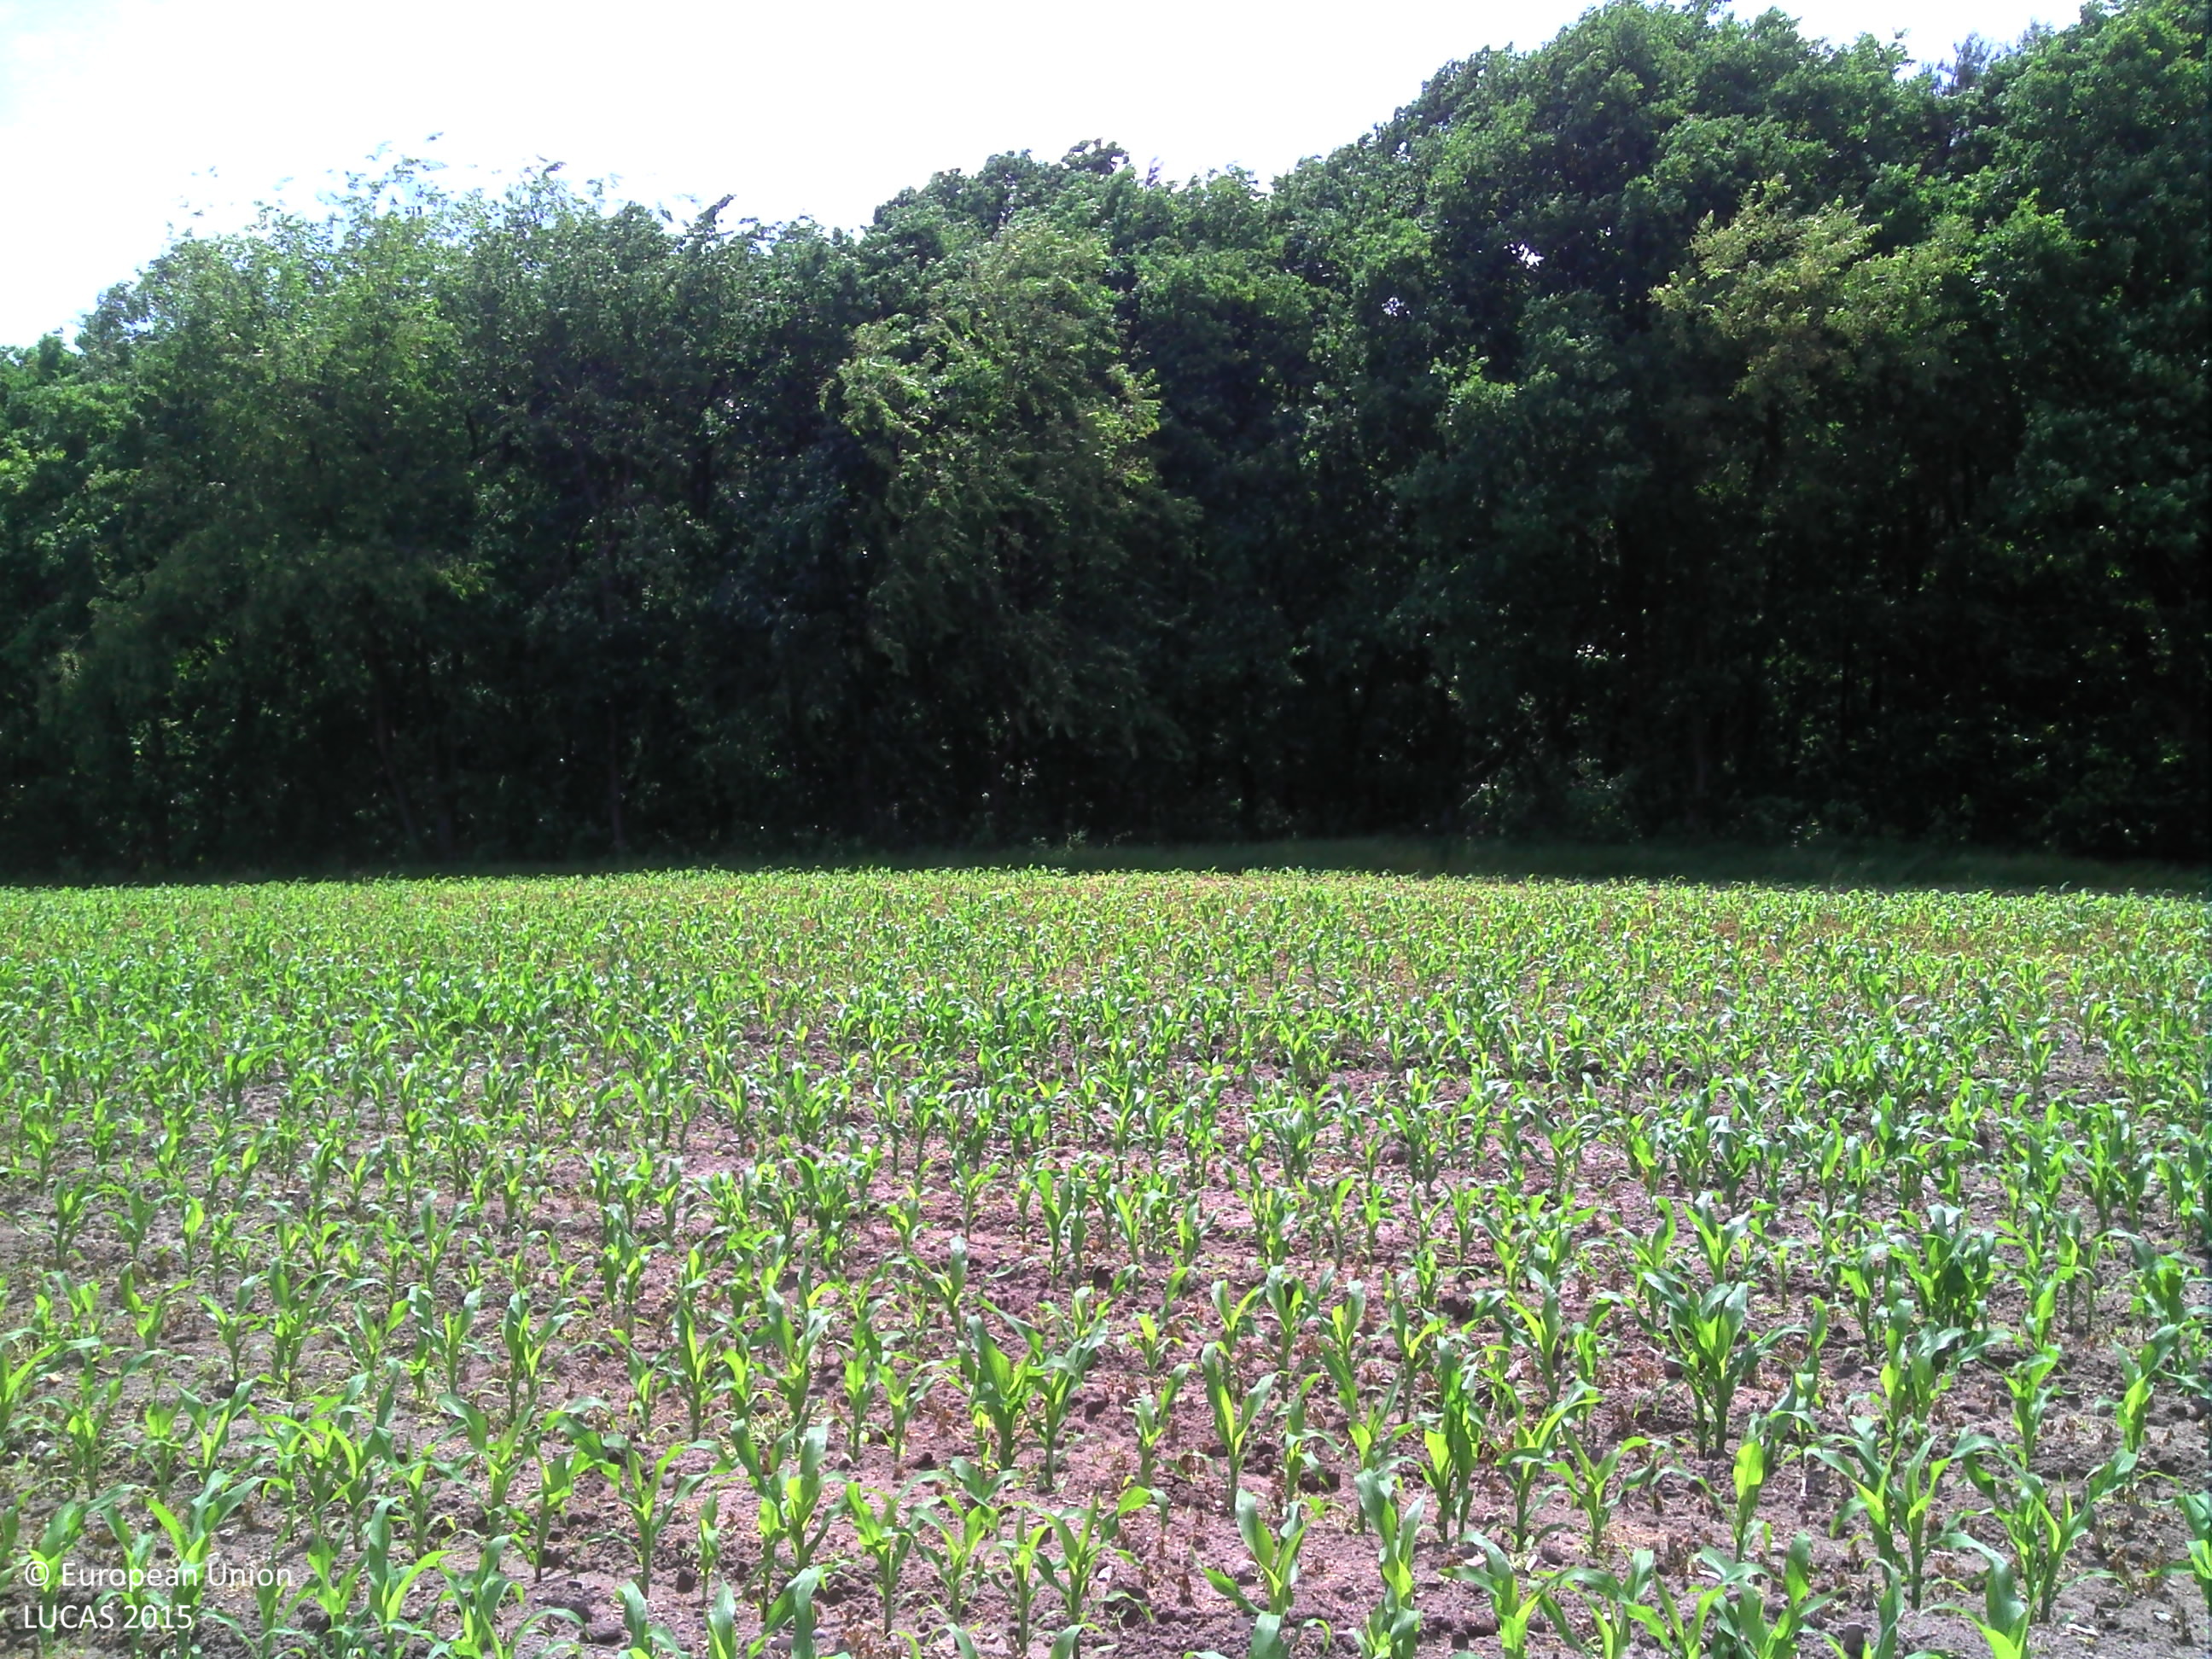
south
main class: Cropland
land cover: Maize
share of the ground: 10 - 25 %
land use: Agriculture (excluding fallow land and kitchen gardens)
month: June
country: BE
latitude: 50.9848
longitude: 5.6822
